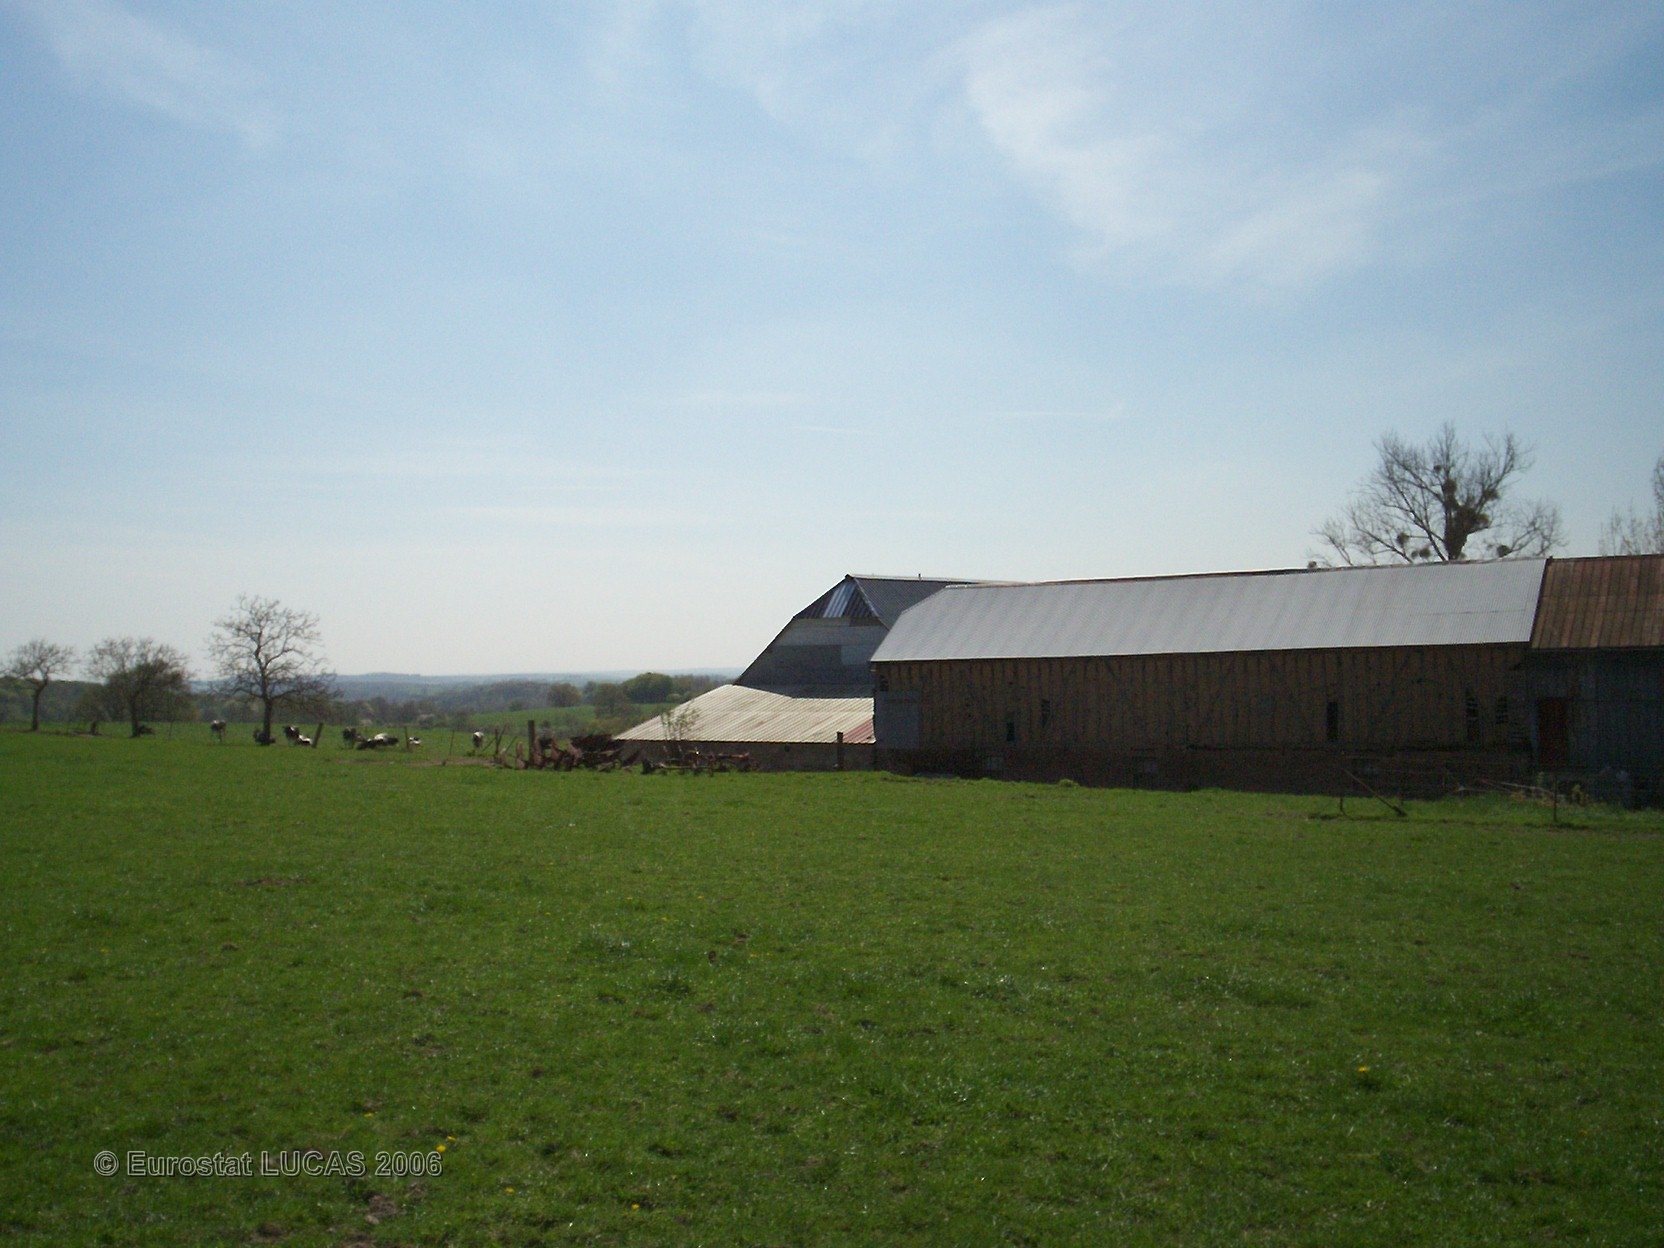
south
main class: Grassland
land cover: Grassland without tree/shrub cover
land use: Agriculture (excluding fallow land and kitchen gardens)
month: April
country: FR
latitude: 49.6825
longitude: 4.3270
